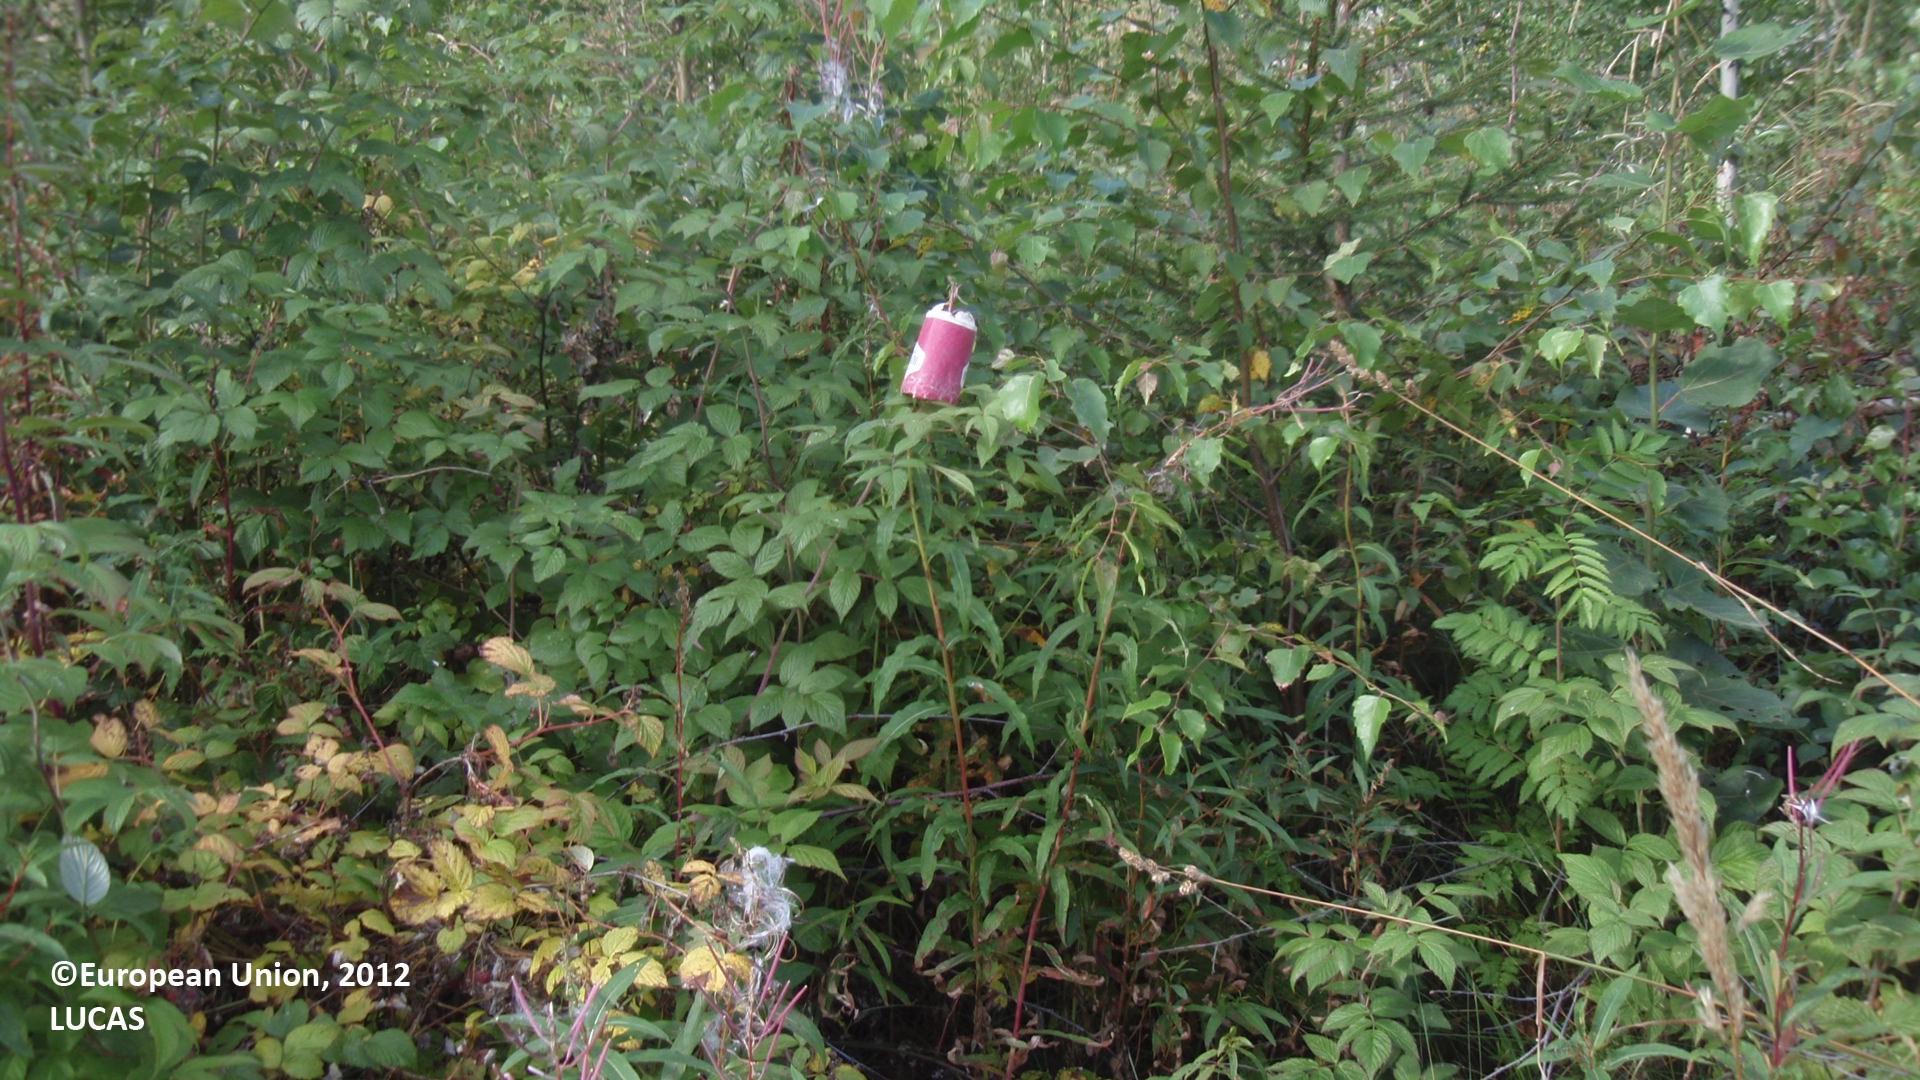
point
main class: Shrubland
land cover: Shrubland with sparse tree cover
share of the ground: > 75 %
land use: Forestry
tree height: < 5 m
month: August
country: FI
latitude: 61.5539
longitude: 27.6656
